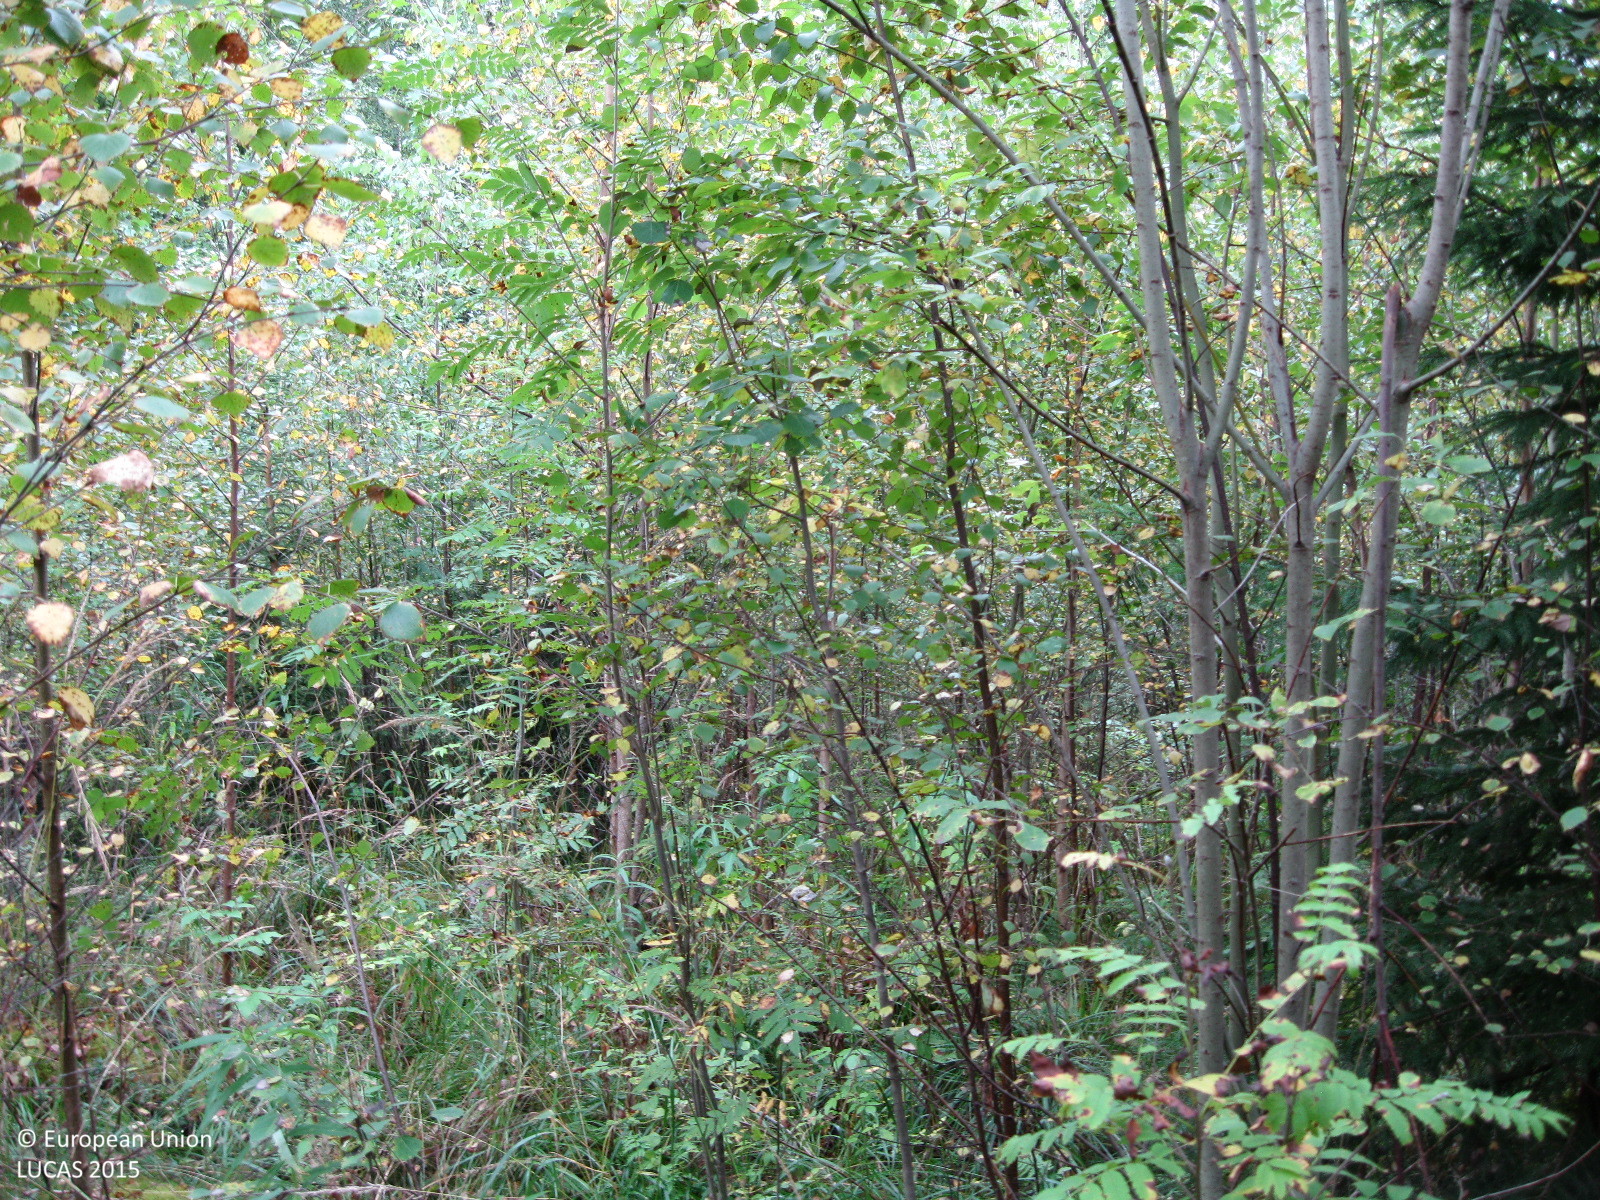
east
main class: Woodland
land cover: Broadleaved woodland
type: boreal forest
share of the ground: > 75 %
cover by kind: broadleaved forest trees 80 %, herbaceous plants 10 %, coniferous forest trees 5 %, shrubs 5 %
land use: Forestry
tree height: > 5 m
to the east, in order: Broadleaved woodland; Spruce dominated mixed woodland; Ditches and canals; Spruce dominated mixed woodland; Ditches and canals; Spruce dominated mixed woodland; Ditches and canals; Other mixed woodland; Ditches and canals; Other mixed woodland
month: September
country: FI
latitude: 60.7973
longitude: 24.9040
